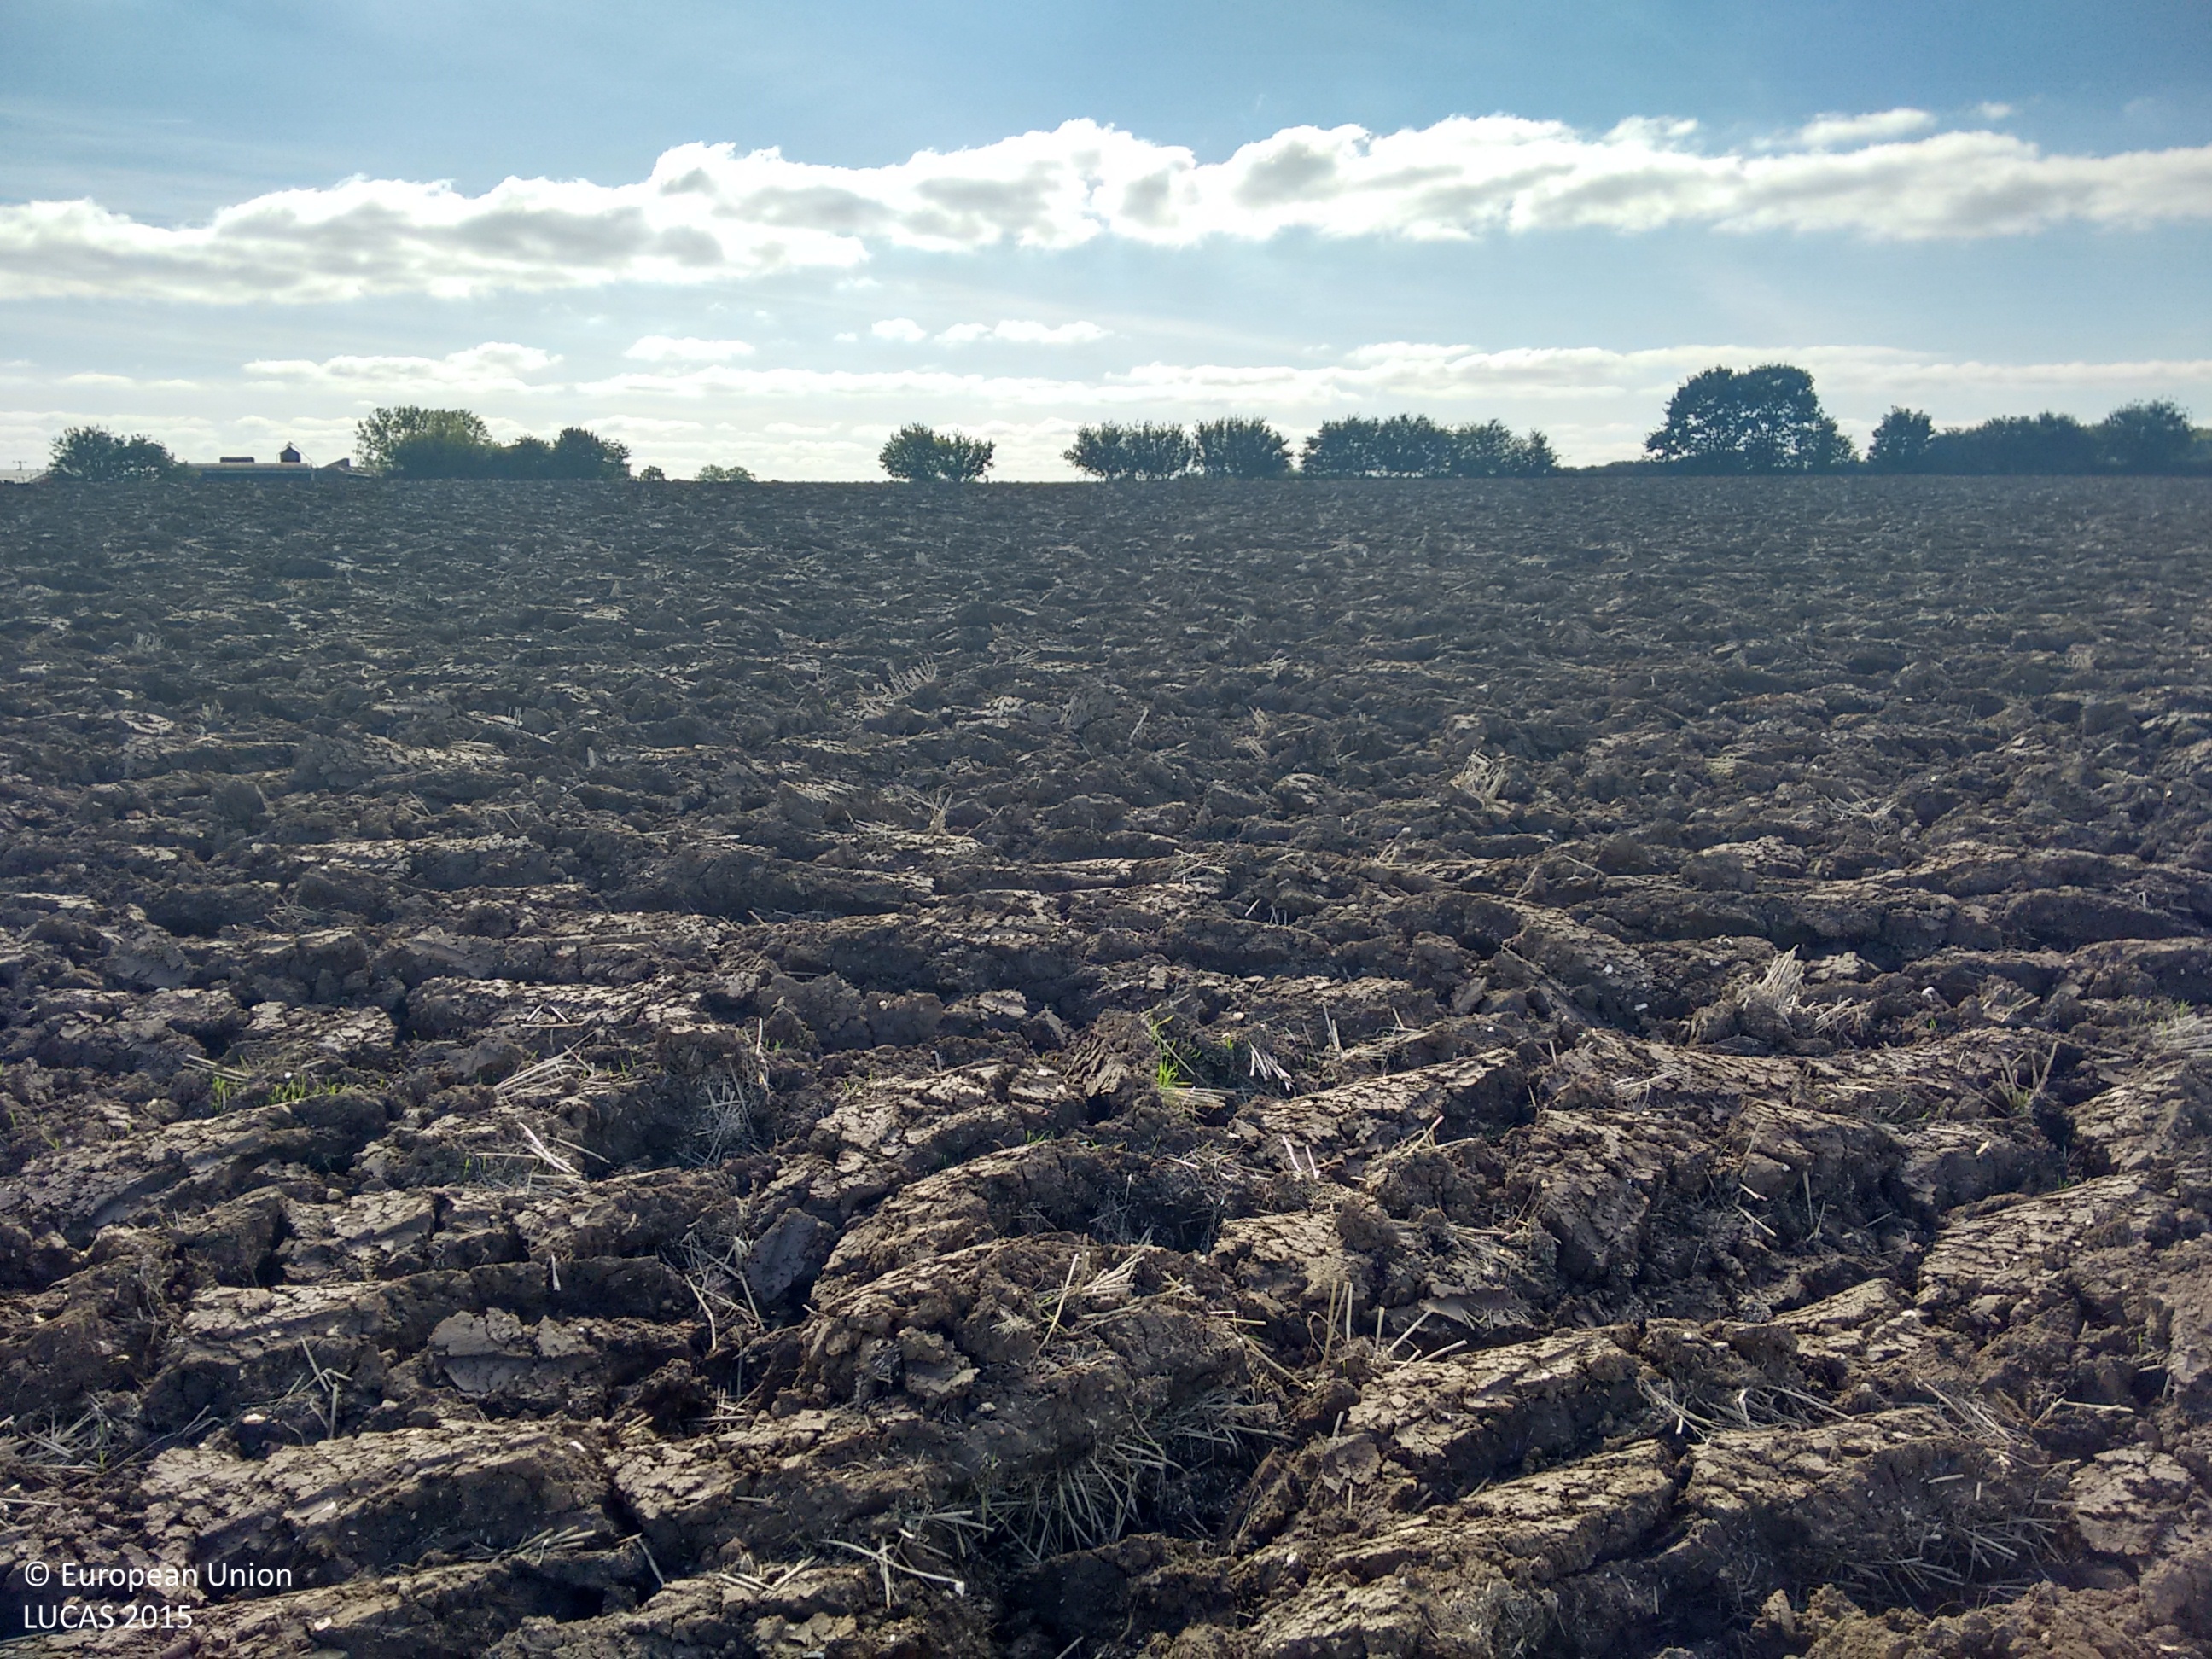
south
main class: Cropland
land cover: Common wheat
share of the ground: < 10 %
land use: Agriculture (excluding fallow land and kitchen gardens)
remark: Harvested field
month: September
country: GB
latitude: 51.9971
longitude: 0.0785
